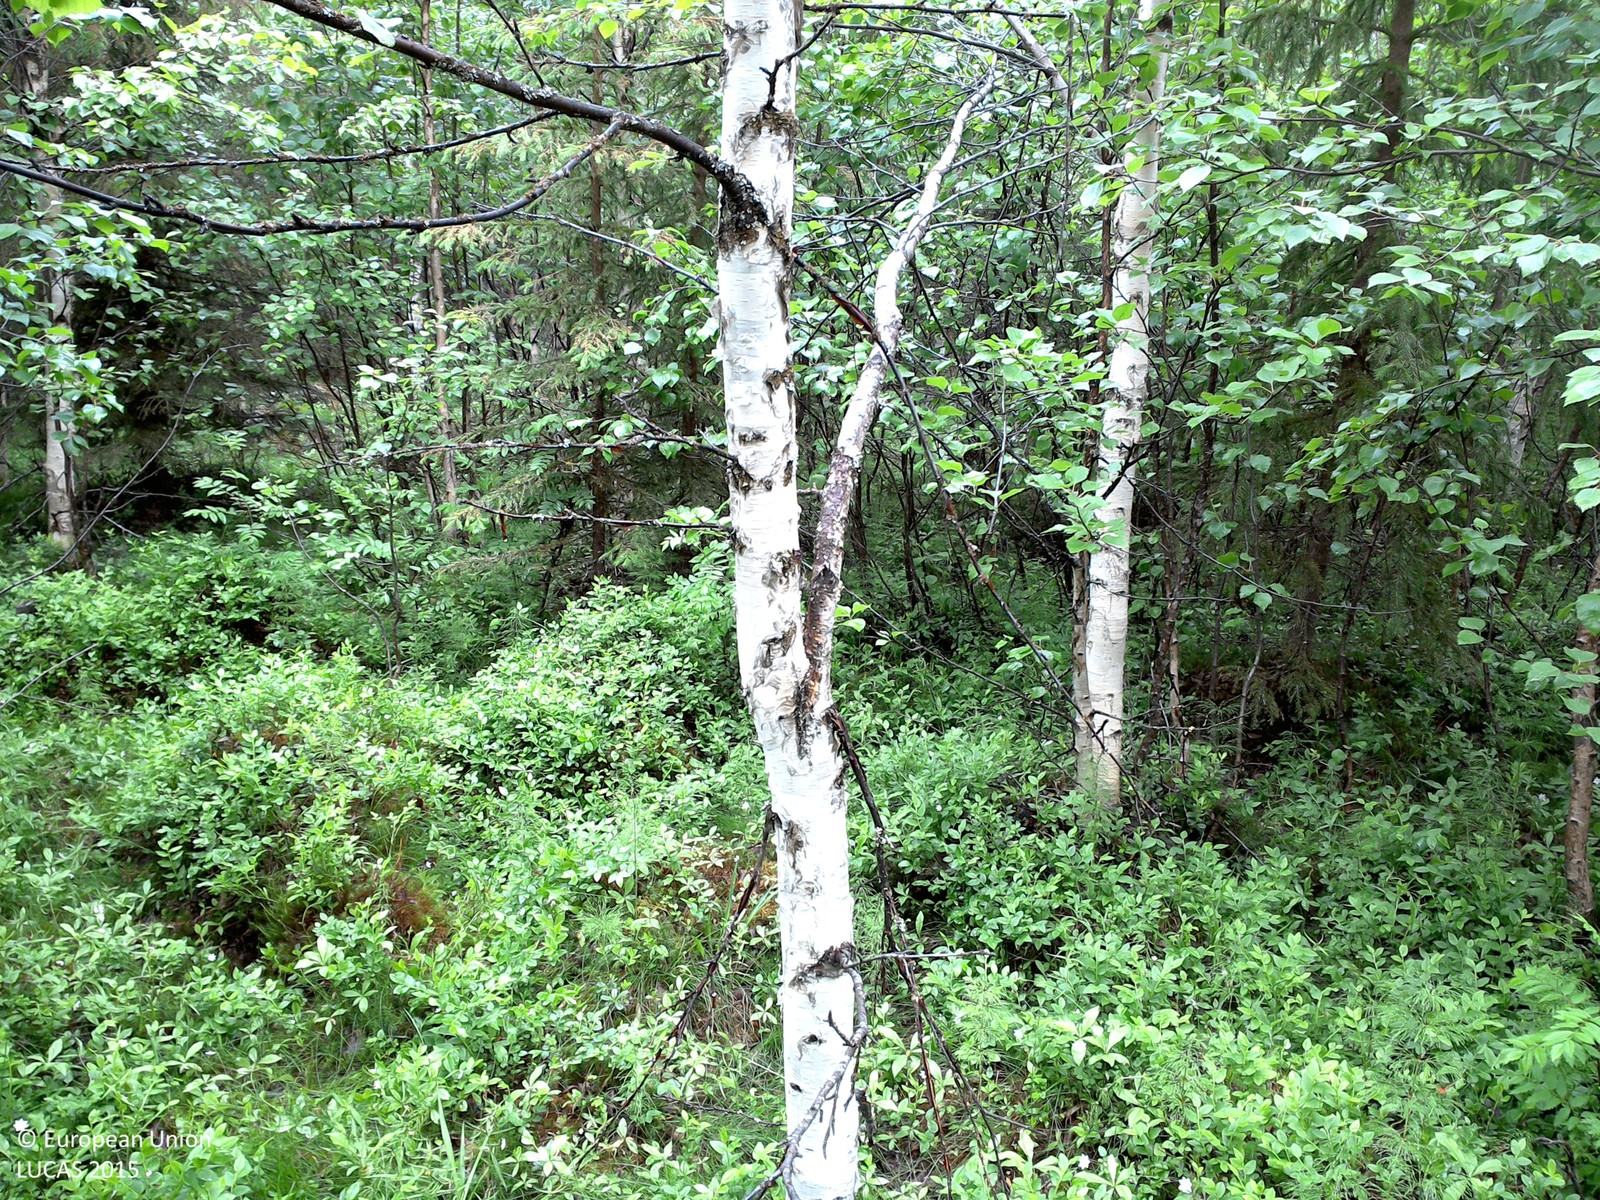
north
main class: Woodland
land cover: Broadleaved woodland
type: boreal forest
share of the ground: 50 - 75 %
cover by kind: broadleaved forest trees 50 %, shrubs 45 %, coniferous forest trees 5 %
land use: Forestry
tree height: > 5 m
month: July
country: SE
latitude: 66.5901
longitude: 23.3561
